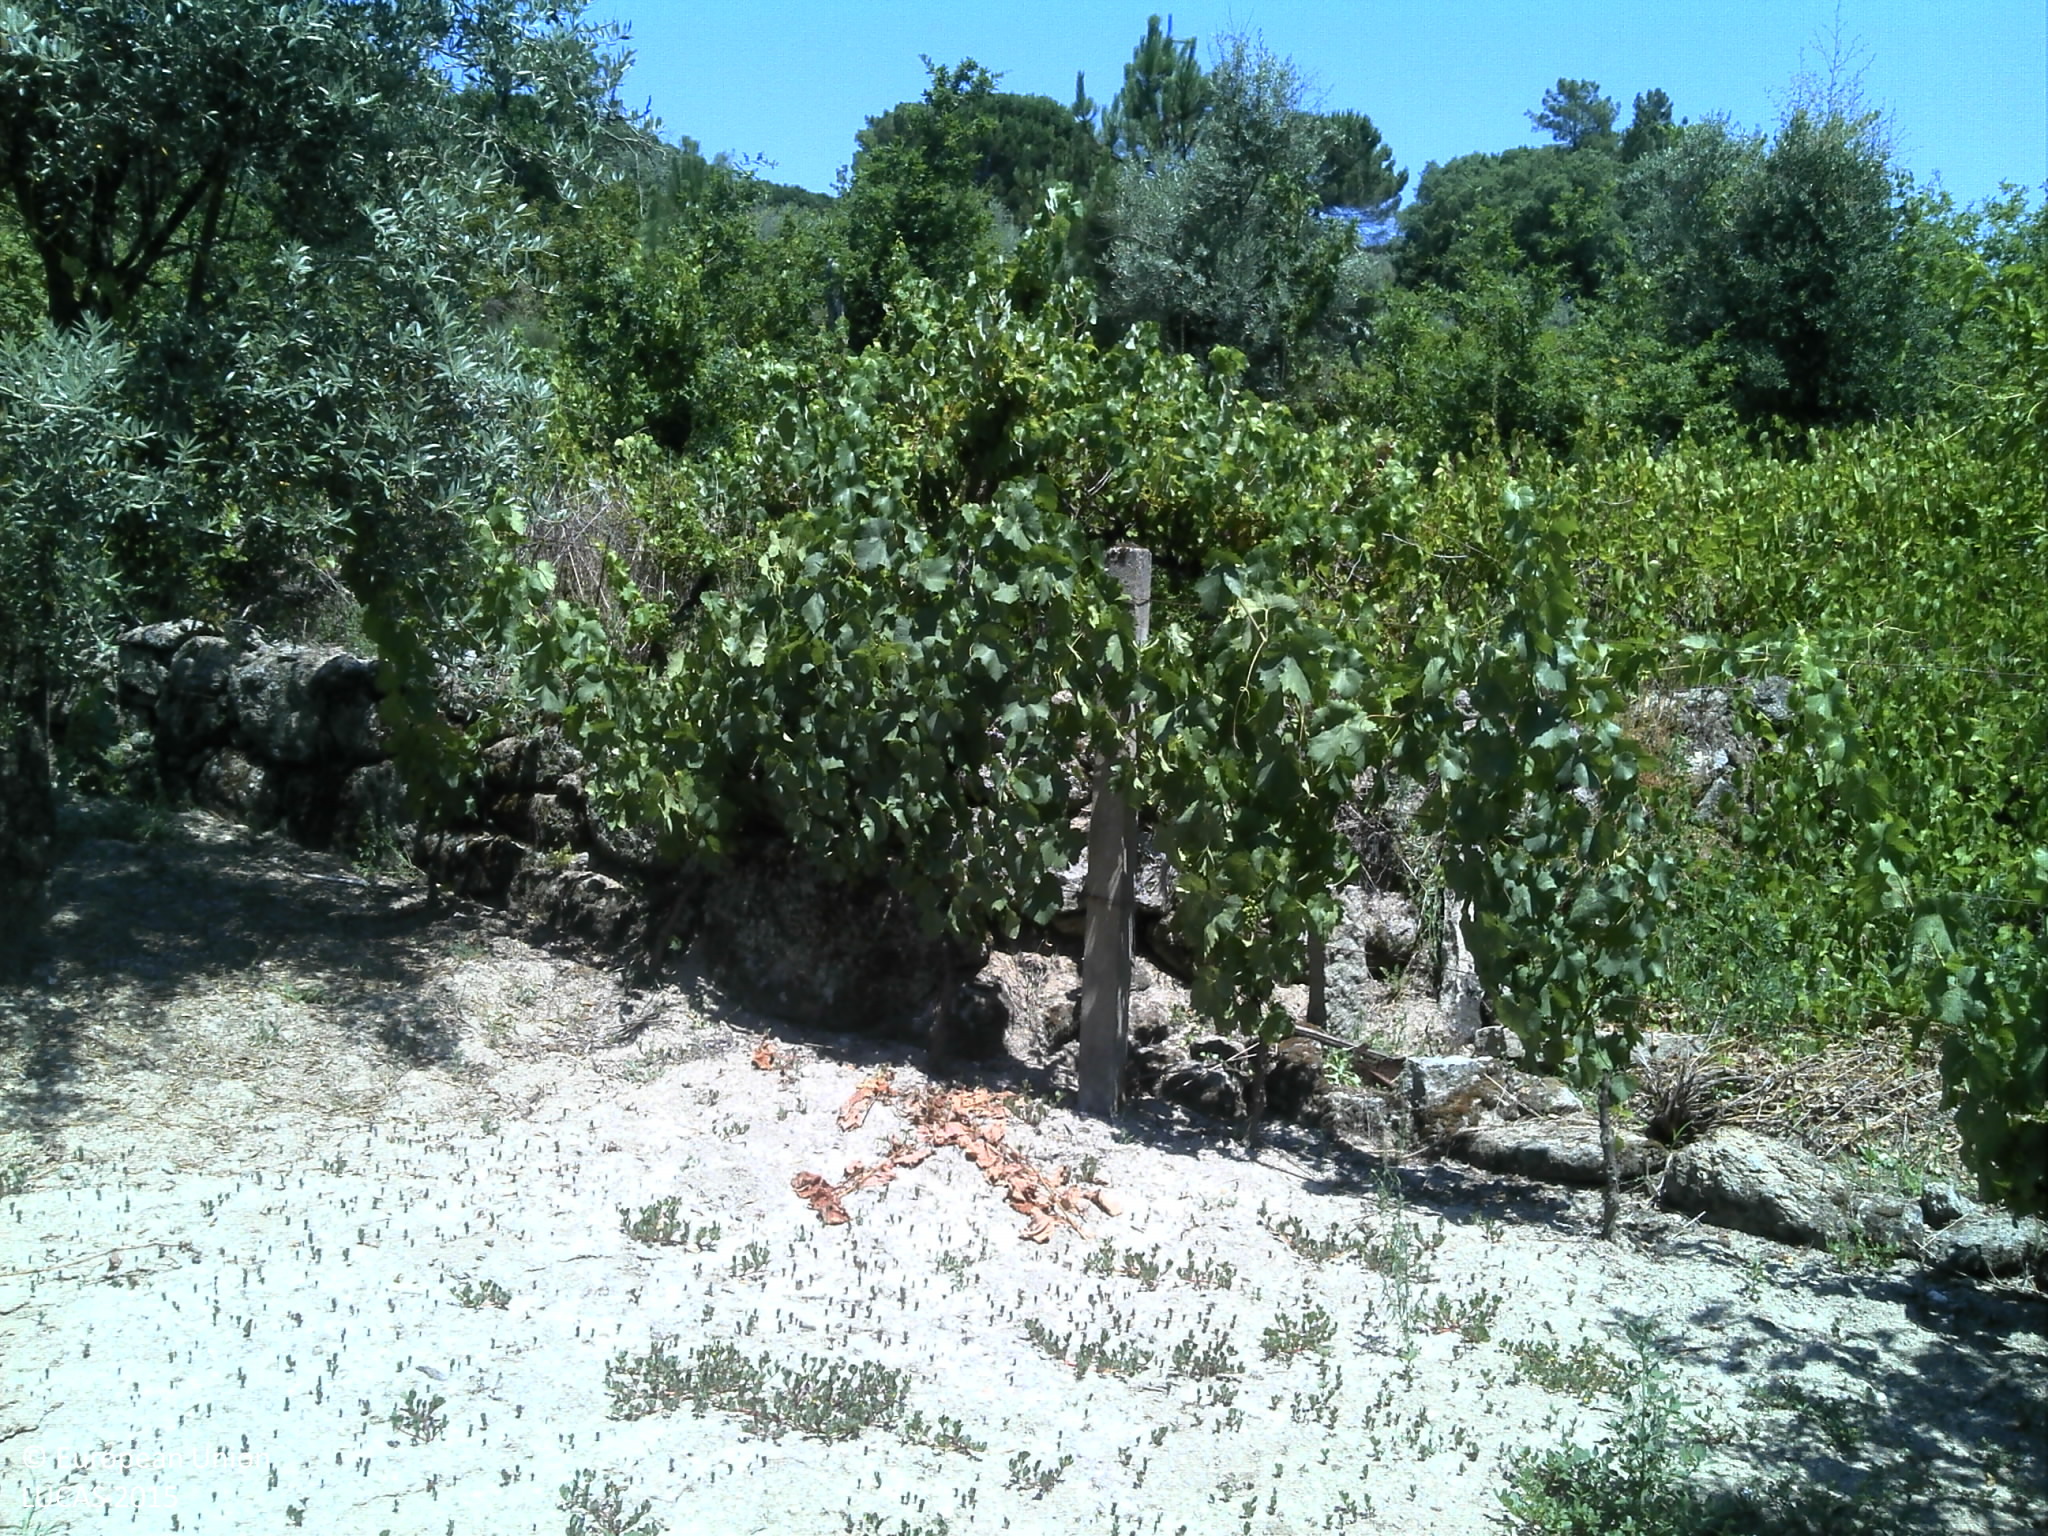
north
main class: Grassland
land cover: Grassland with sparse tree/shrub cover
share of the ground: 10 - 25 %
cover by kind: unconsolidated bare surface 70 %, herbaceous plants 25 %, broadleaved forest trees 5 %
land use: Agriculture (excluding fallow land and kitchen gardens)
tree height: > 5 m
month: June
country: PT
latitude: 40.5516
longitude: -7.9671
